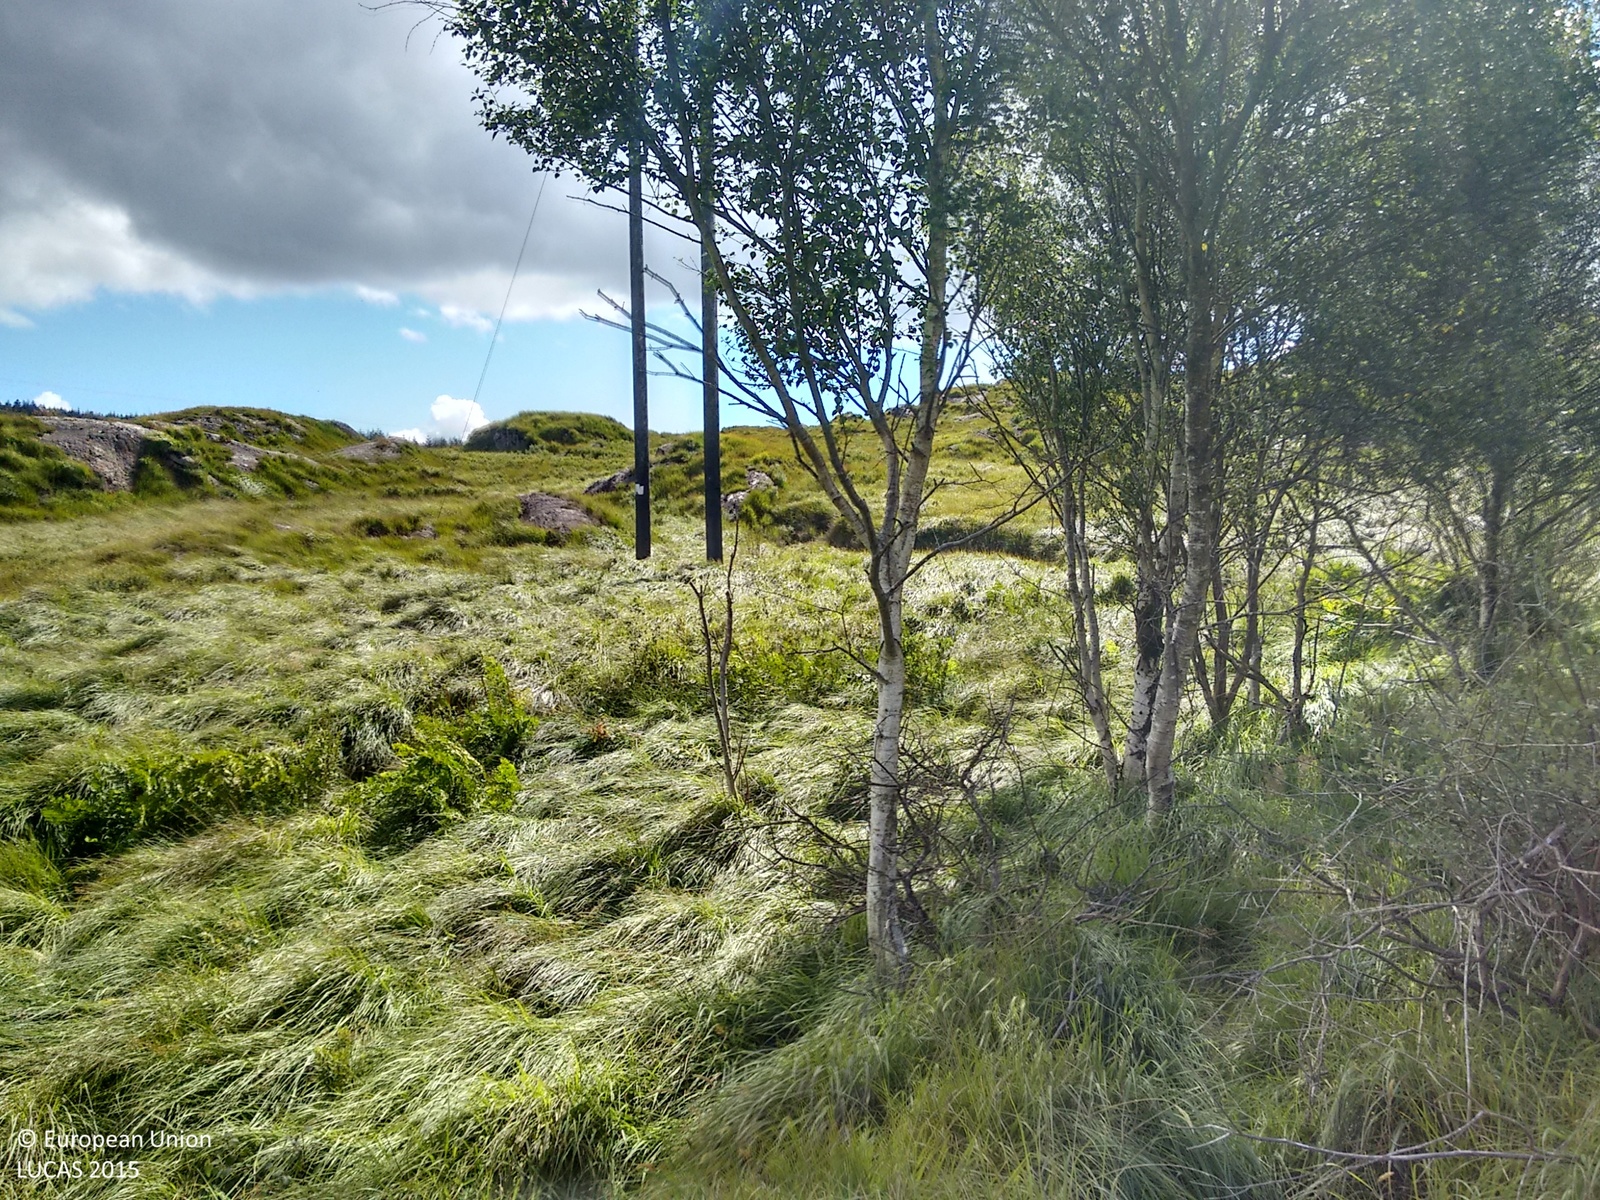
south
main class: Grassland
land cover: Grassland without tree/shrub cover
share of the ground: > 75 %
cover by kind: herbaceous plants 60 %, consolidated bare surface 40 %
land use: Semi-natural and natural areas not in use
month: August
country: IE
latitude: 51.7406
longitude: -9.4786
